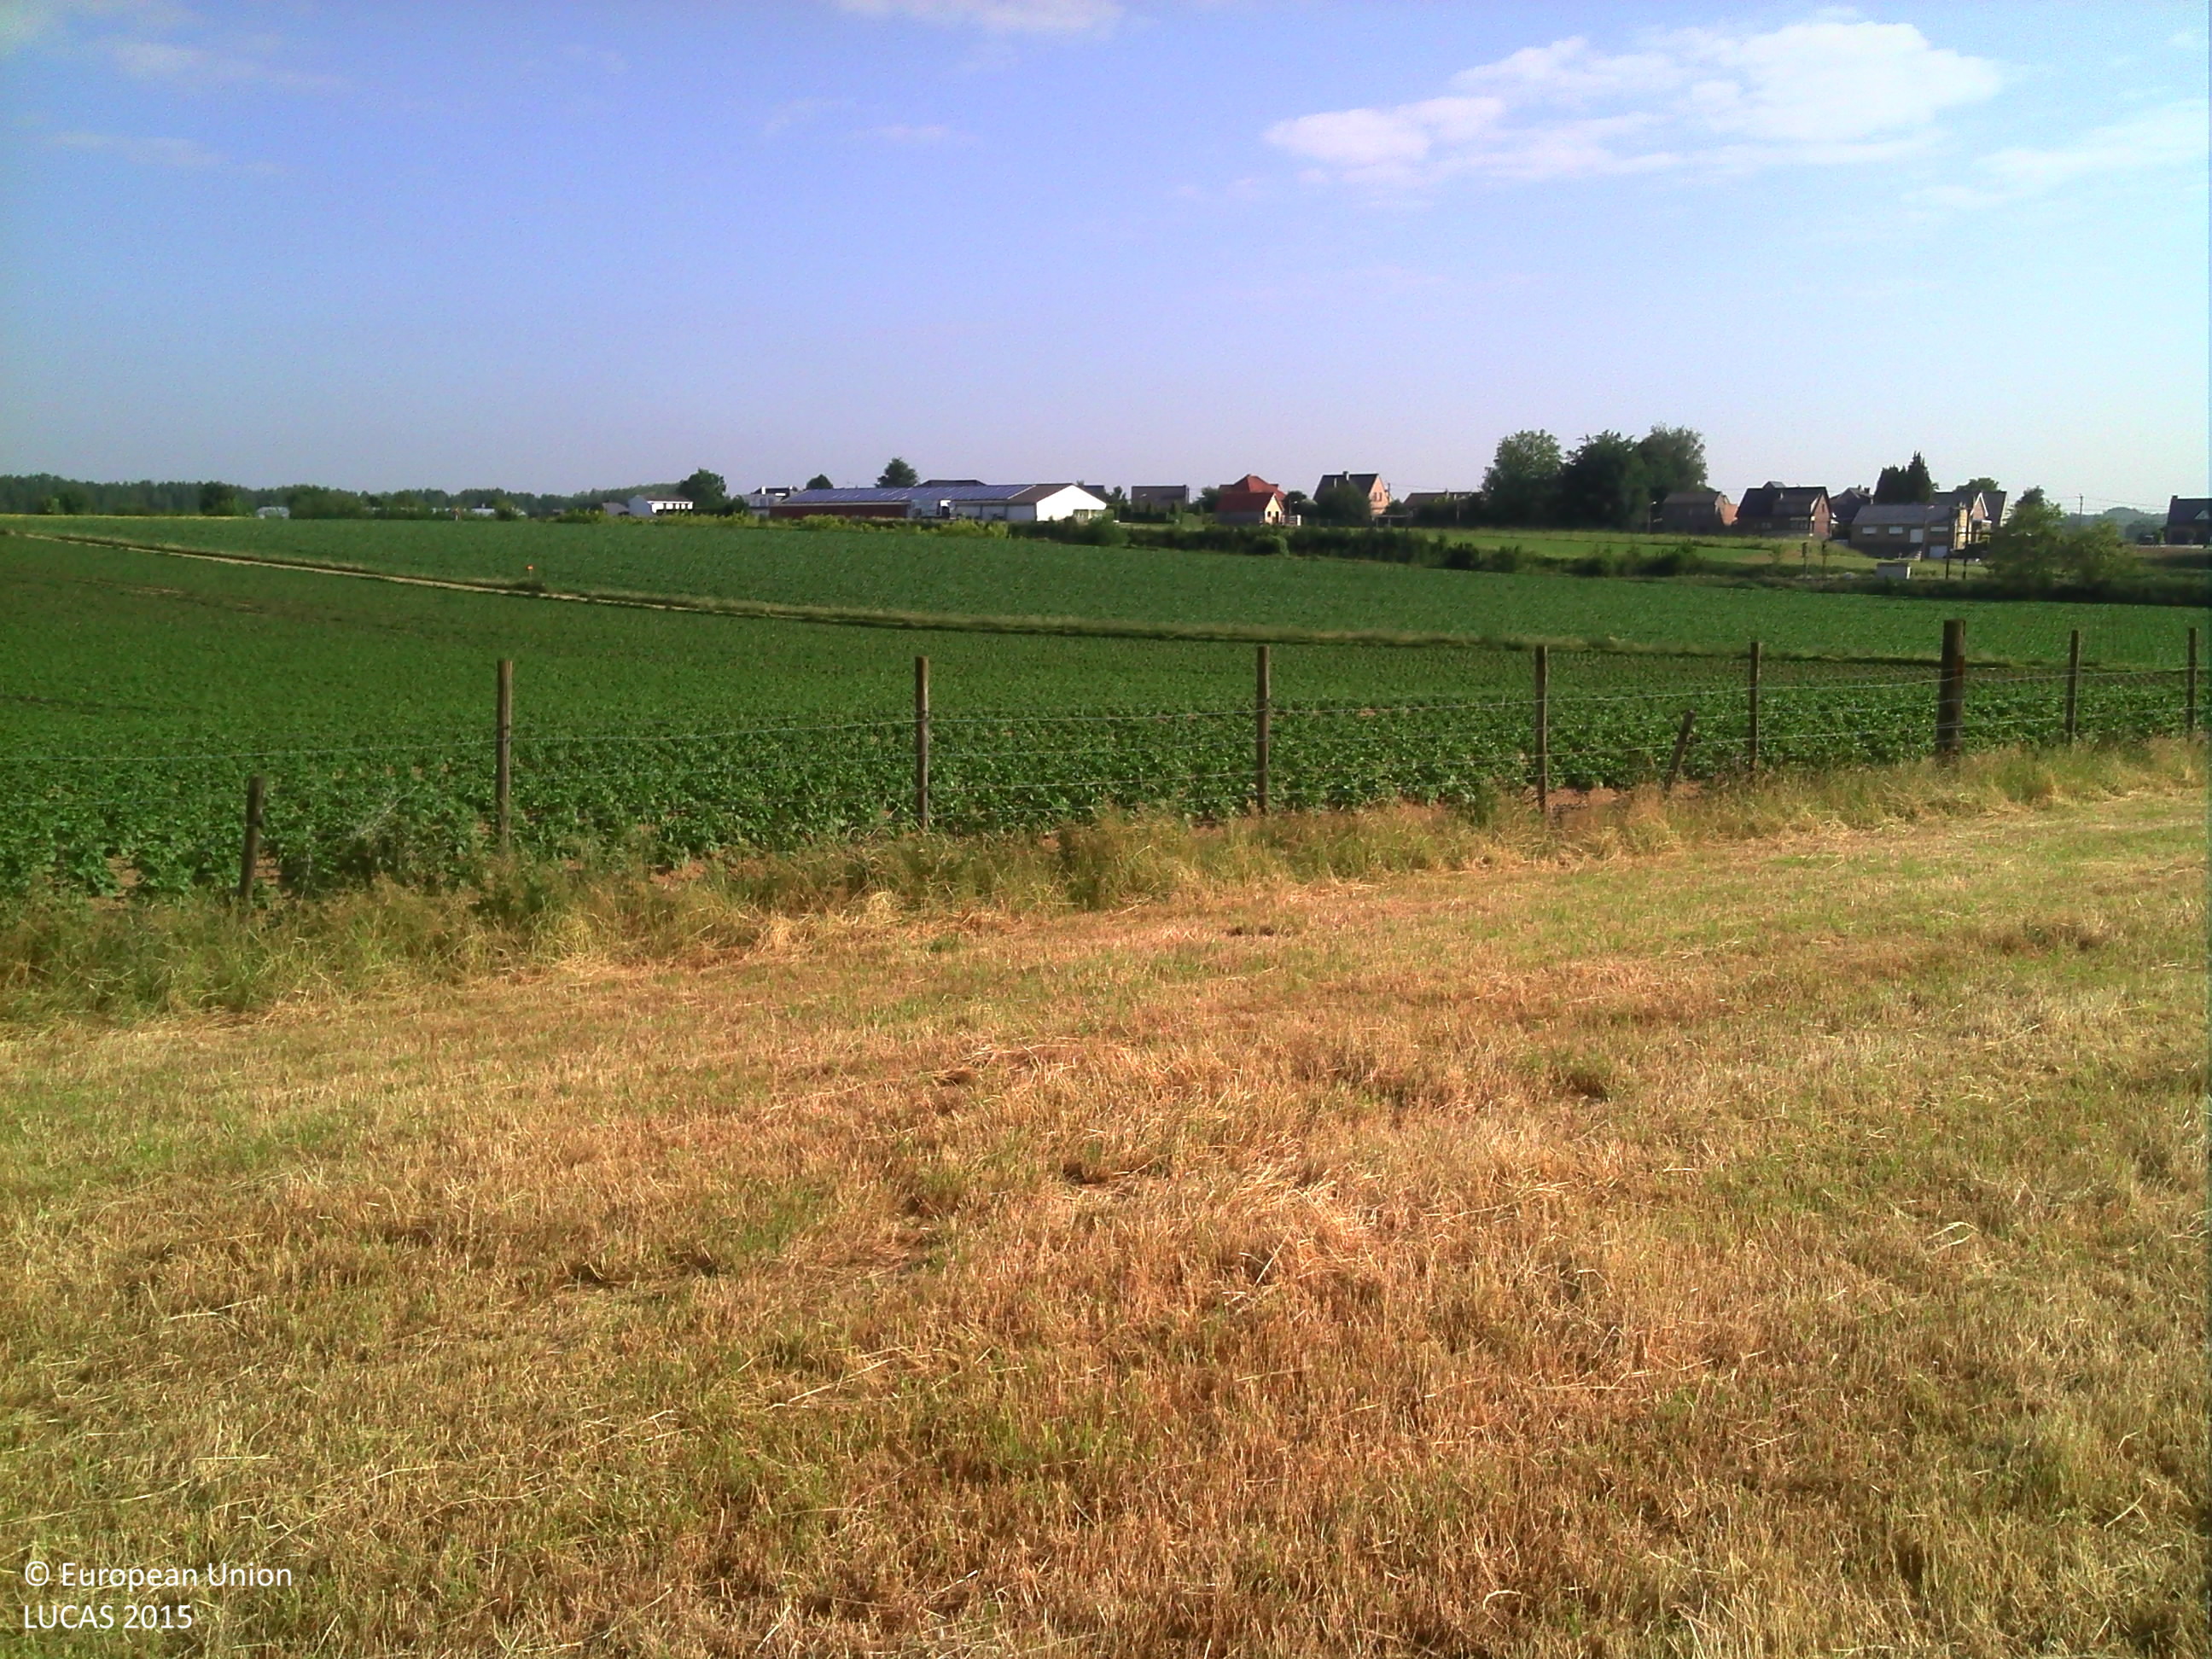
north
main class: Grassland
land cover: Grassland without tree/shrub cover
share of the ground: > 75 %
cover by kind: herbaceous plants 100 %
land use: Agriculture (excluding fallow land and kitchen gardens)
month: June
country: BE
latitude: 50.7619
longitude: 5.5040
